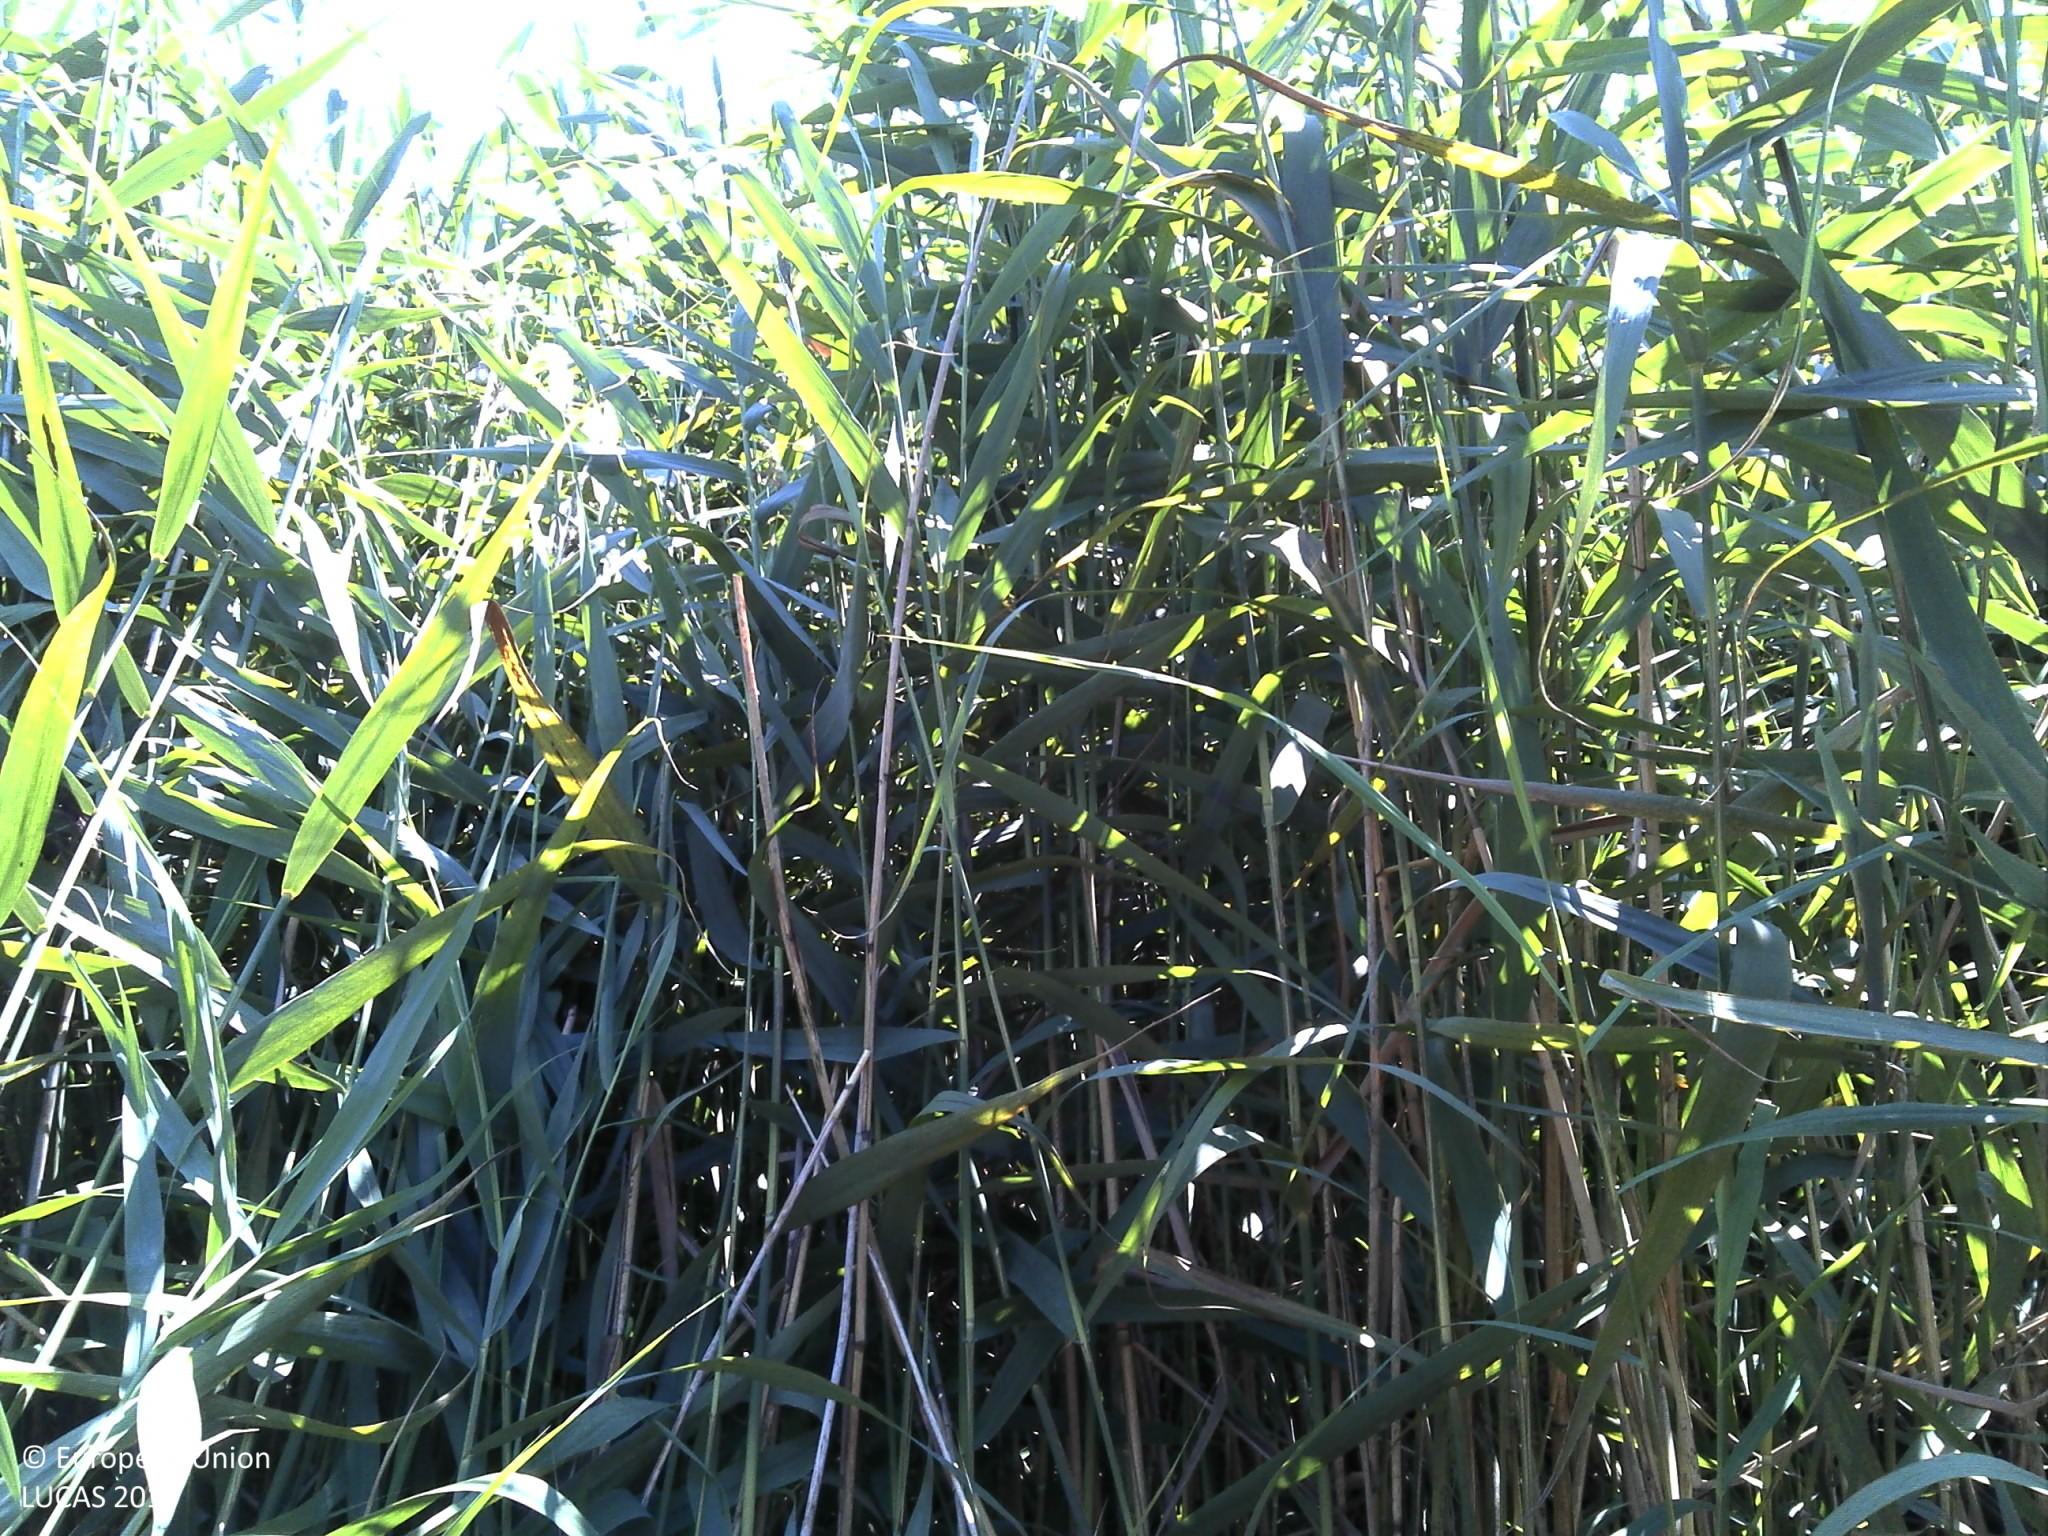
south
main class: Grassland
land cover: Spontaneously vegetated surfaces
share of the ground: > 75 %
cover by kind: herbaceous plants 100 %
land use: Semi-natural and natural areas not in use
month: July
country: HR
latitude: 45.4257
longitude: 16.8623
